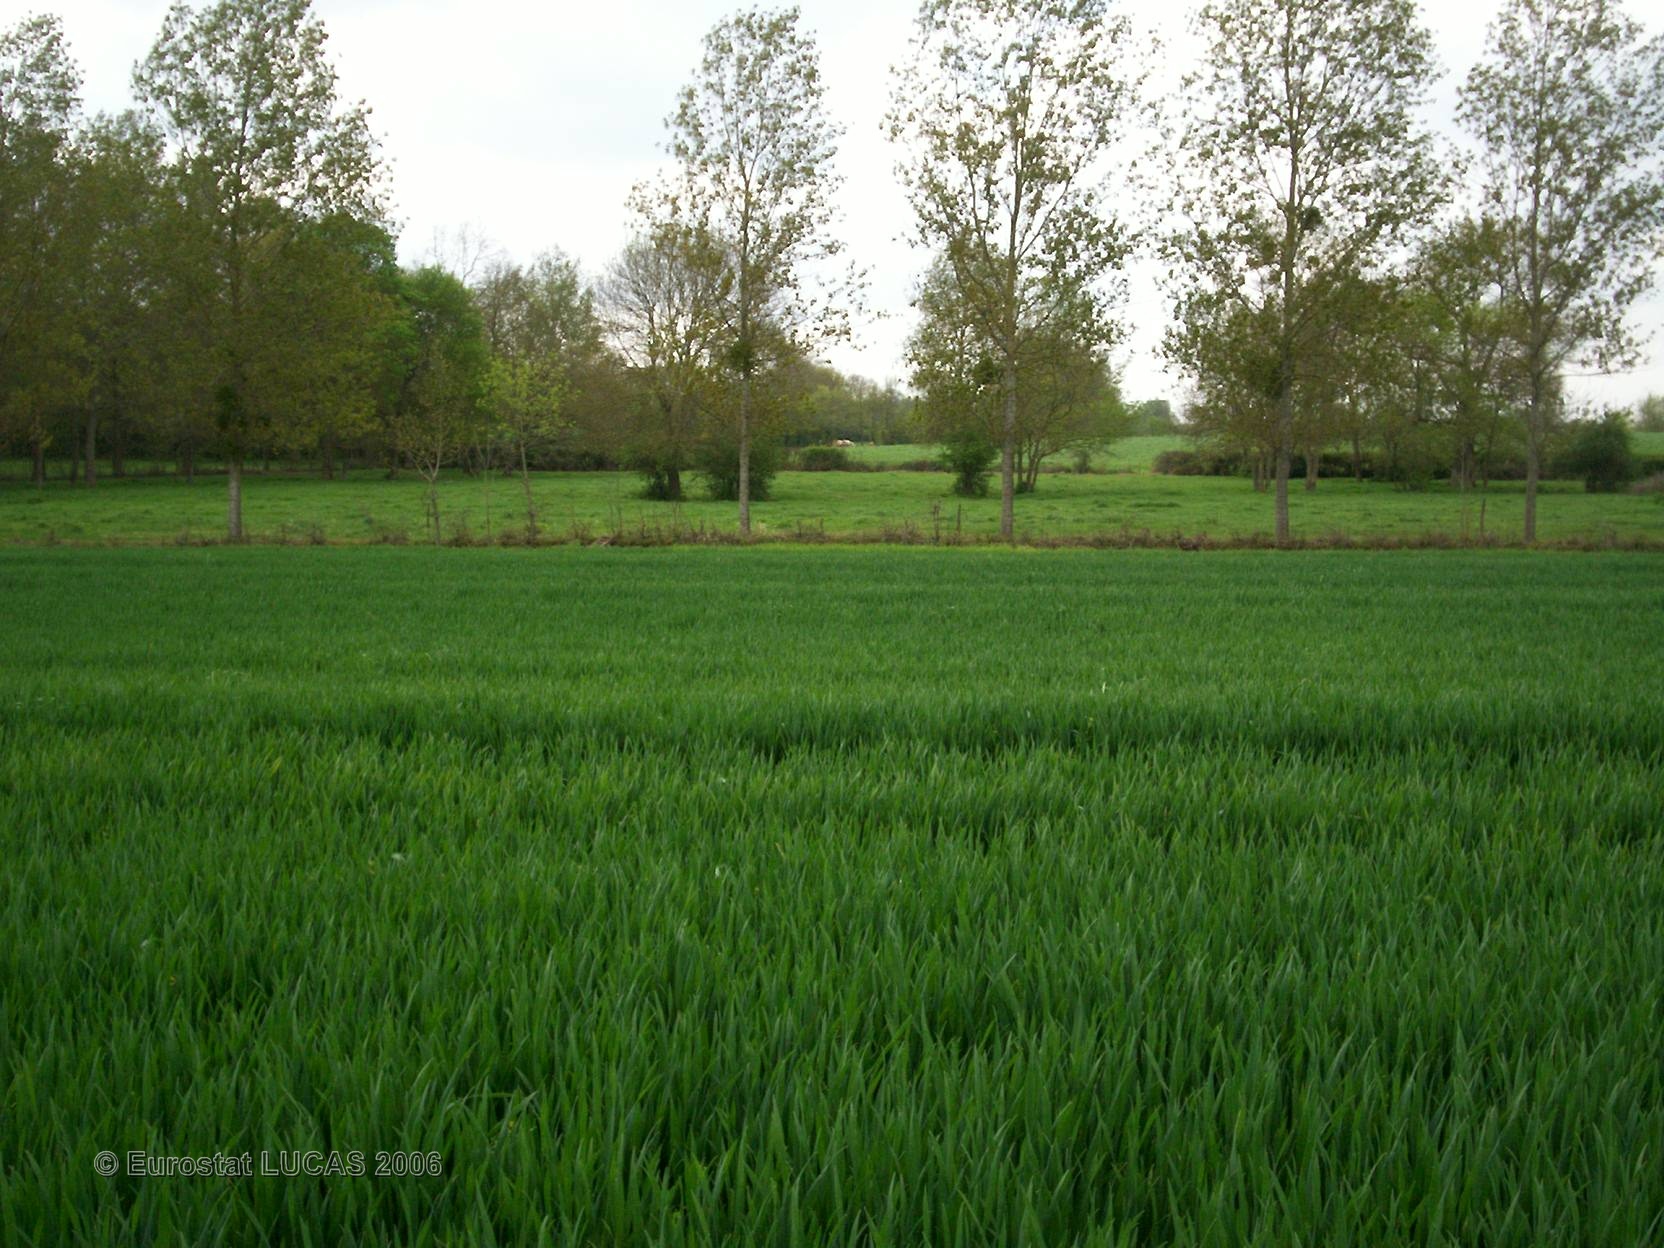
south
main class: Cropland
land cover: Common wheat
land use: Agriculture (excluding fallow land and kitchen gardens)
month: April
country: FR
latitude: 47.0472
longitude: -0.3337
